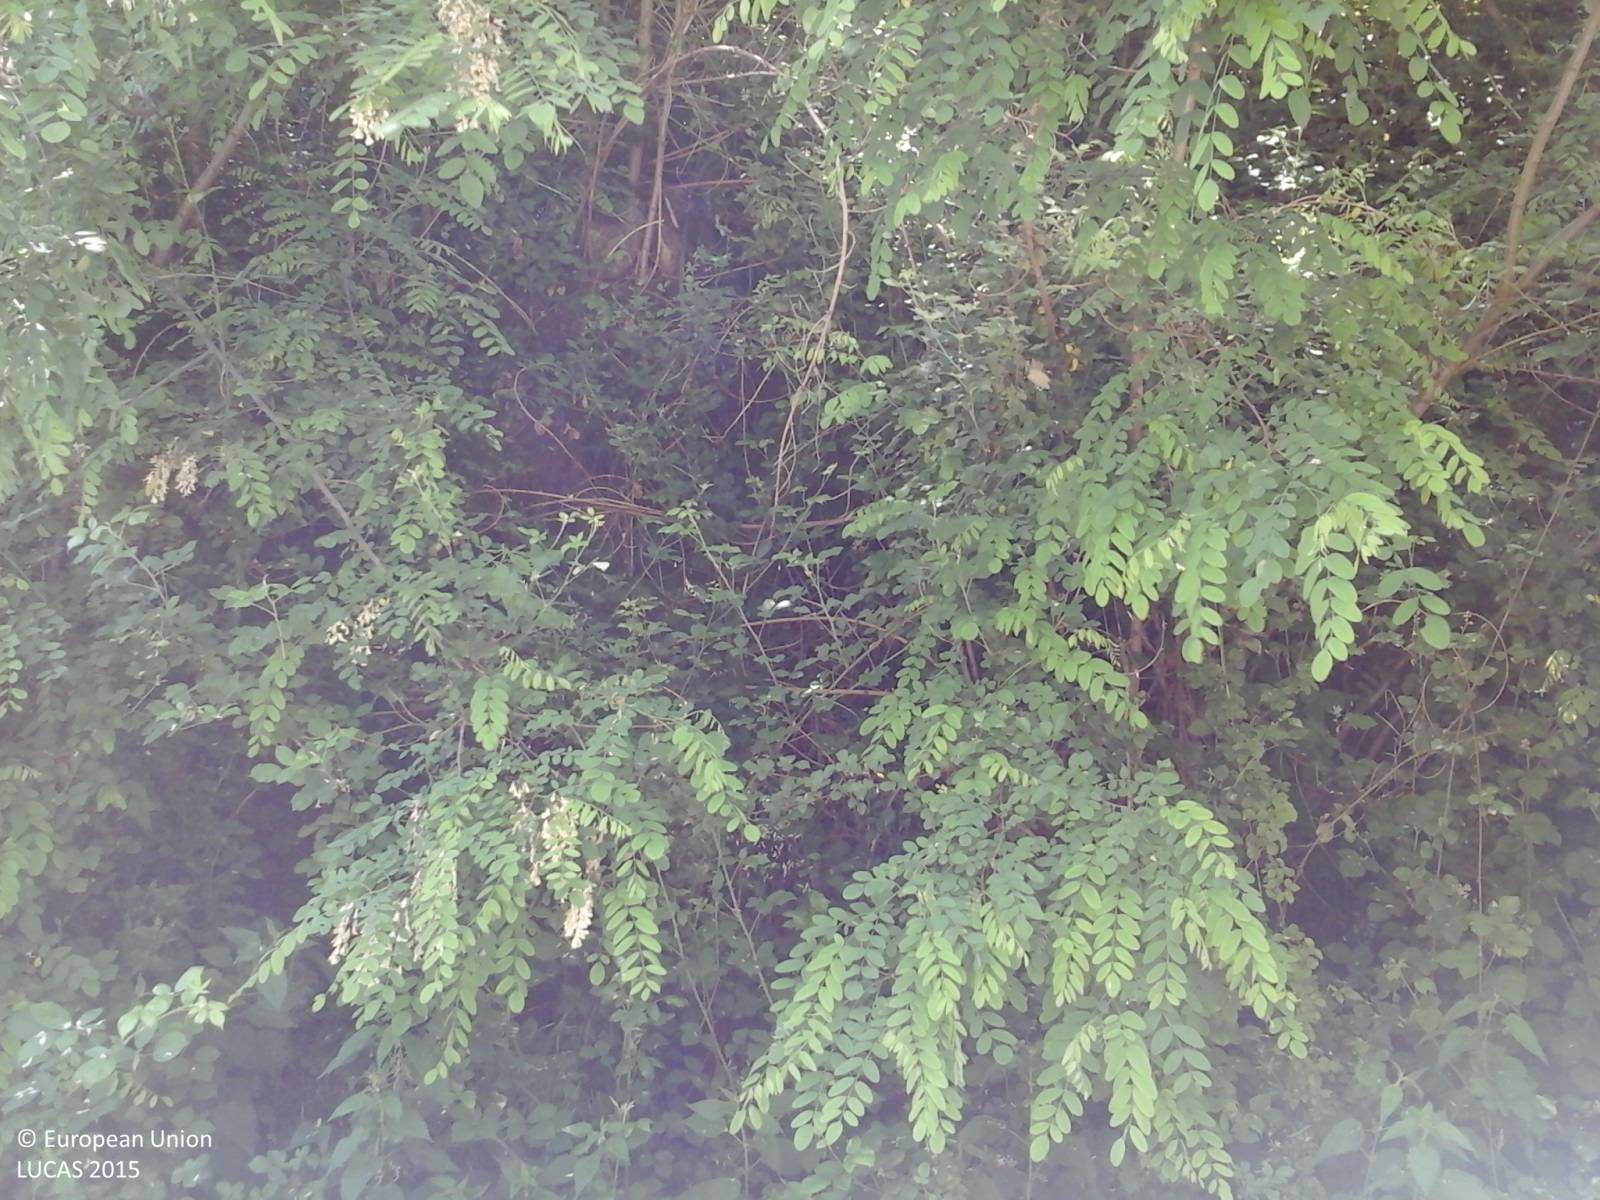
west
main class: Woodland
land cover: Broadleaved woodland
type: thermophilous deciduous forest
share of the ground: > 75 %
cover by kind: broadleaved forest trees 75 %, shrubs 15 %, herbaceous plants 10 %
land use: Forestry
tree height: > 5 m
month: May
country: IT
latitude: 42.1201
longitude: 13.0496
